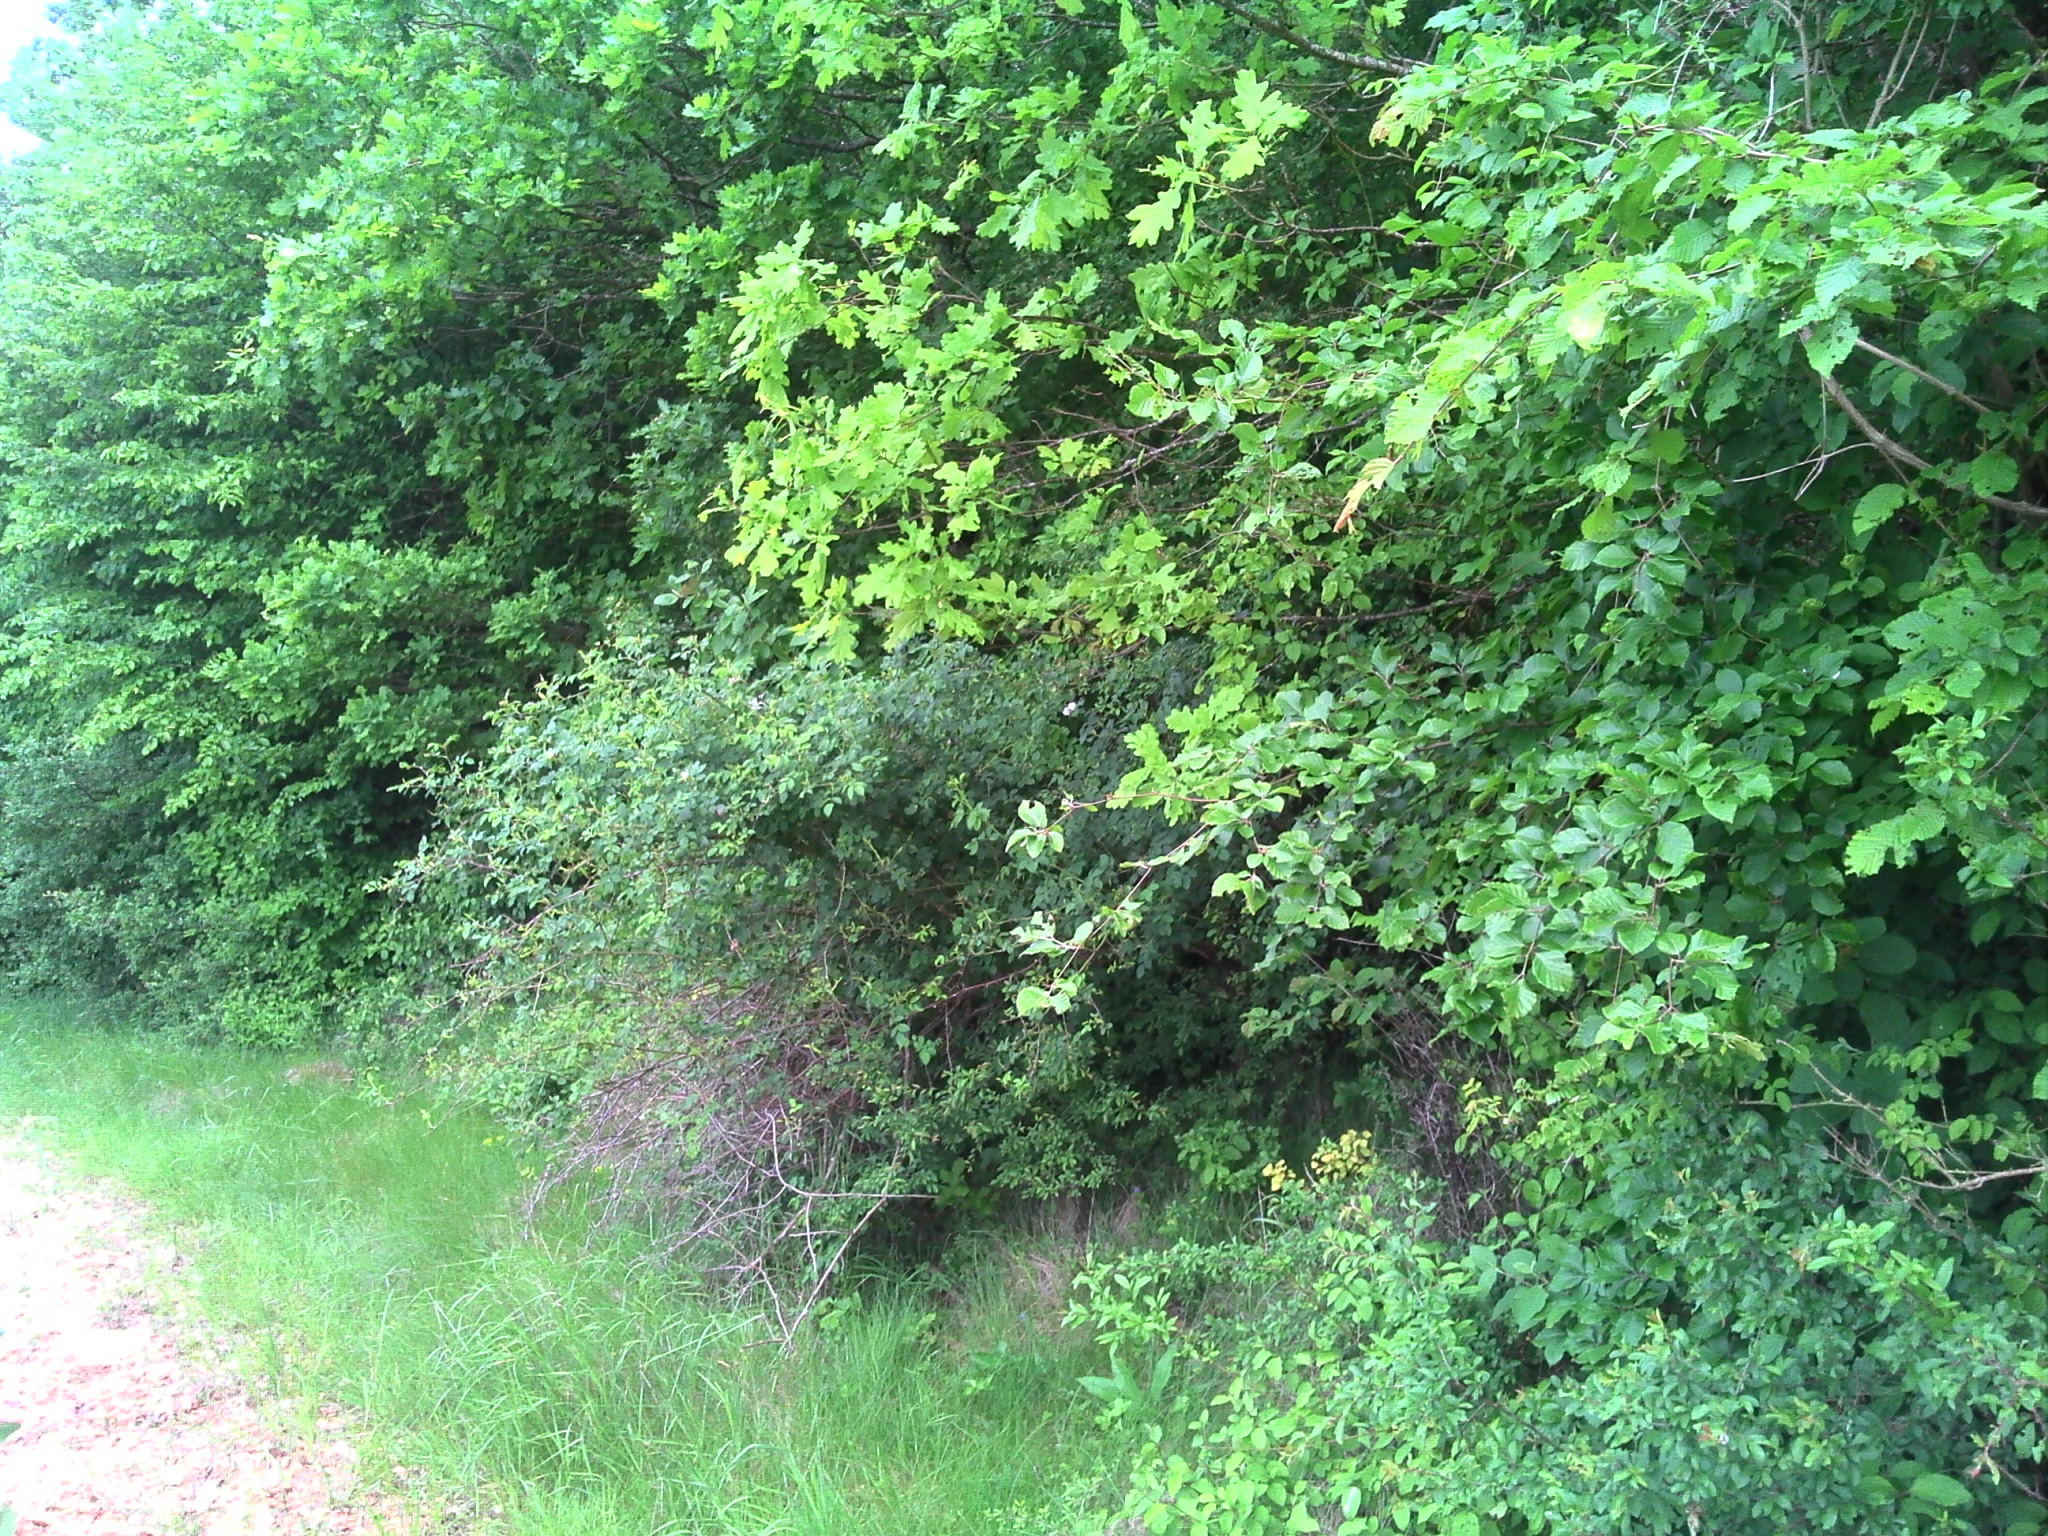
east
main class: Cropland
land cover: Rape and turnip rape
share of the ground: > 75 %
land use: Agriculture (excluding fallow land and kitchen gardens)
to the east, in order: Rape and turnip rape; Lines of trees; Tracks; Broadleaved woodland
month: May
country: FR
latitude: 47.4981
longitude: 5.0221
